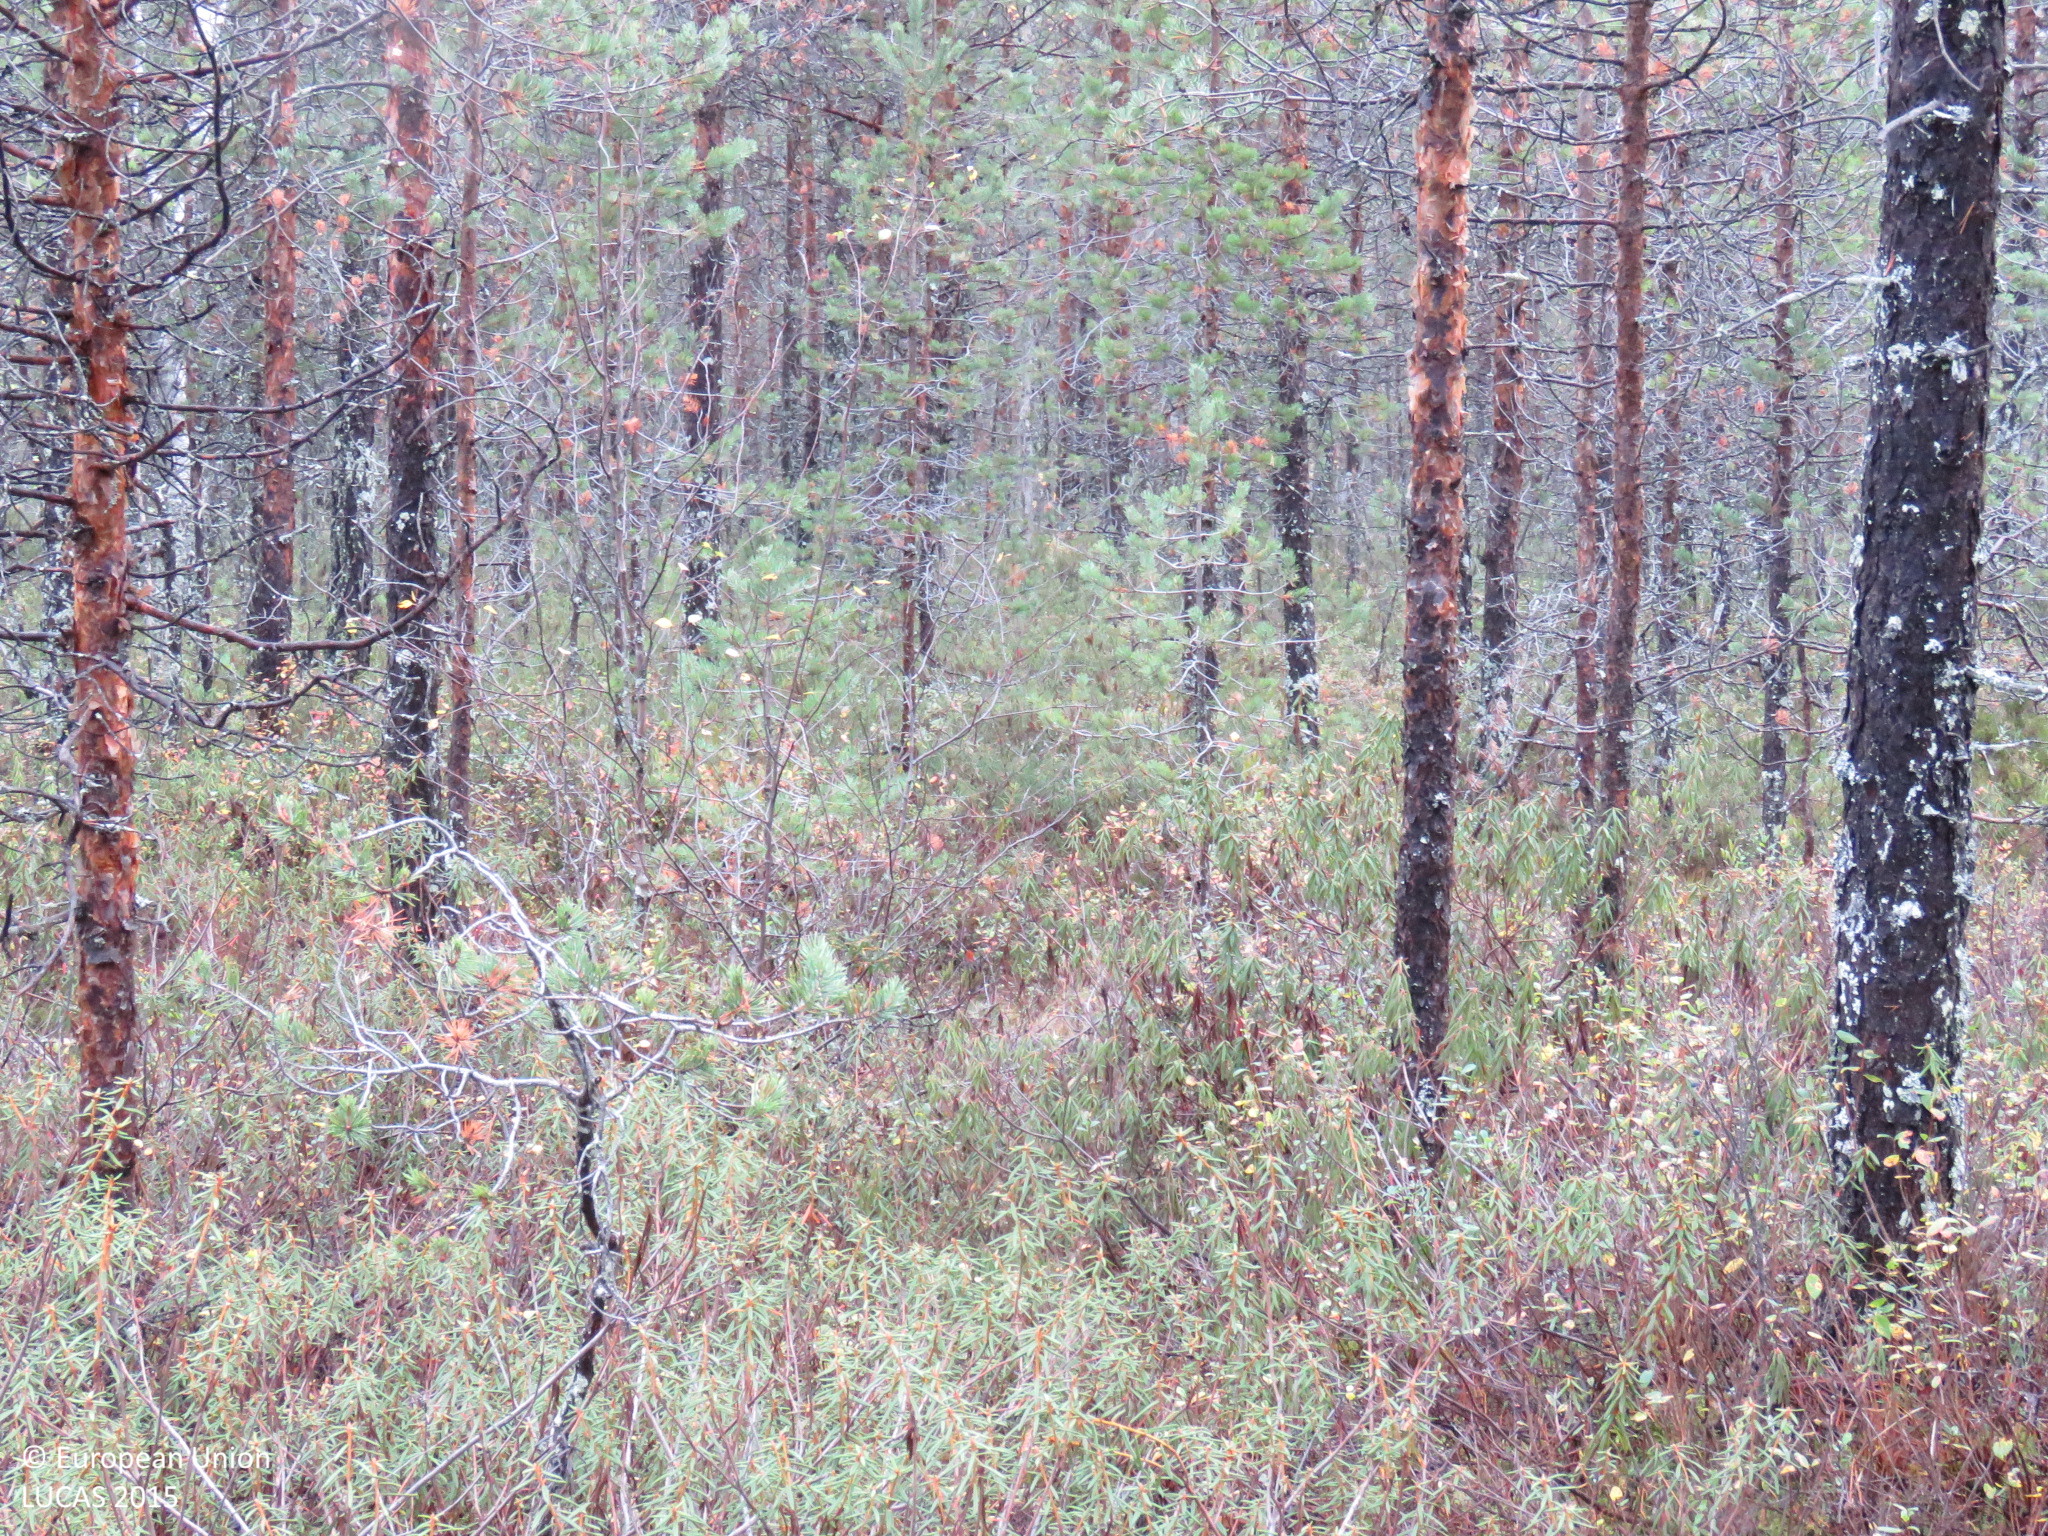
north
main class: Woodland
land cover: Pine dominated coniferous woodland
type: boreal forest
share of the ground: > 75 %
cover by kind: coniferous forest trees 80 %, shrubs 15 %, lichens and mosses 5 %
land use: Forestry
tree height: > 5 m
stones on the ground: < 10 %
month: September
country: FI
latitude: 65.1487
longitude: 26.7682
